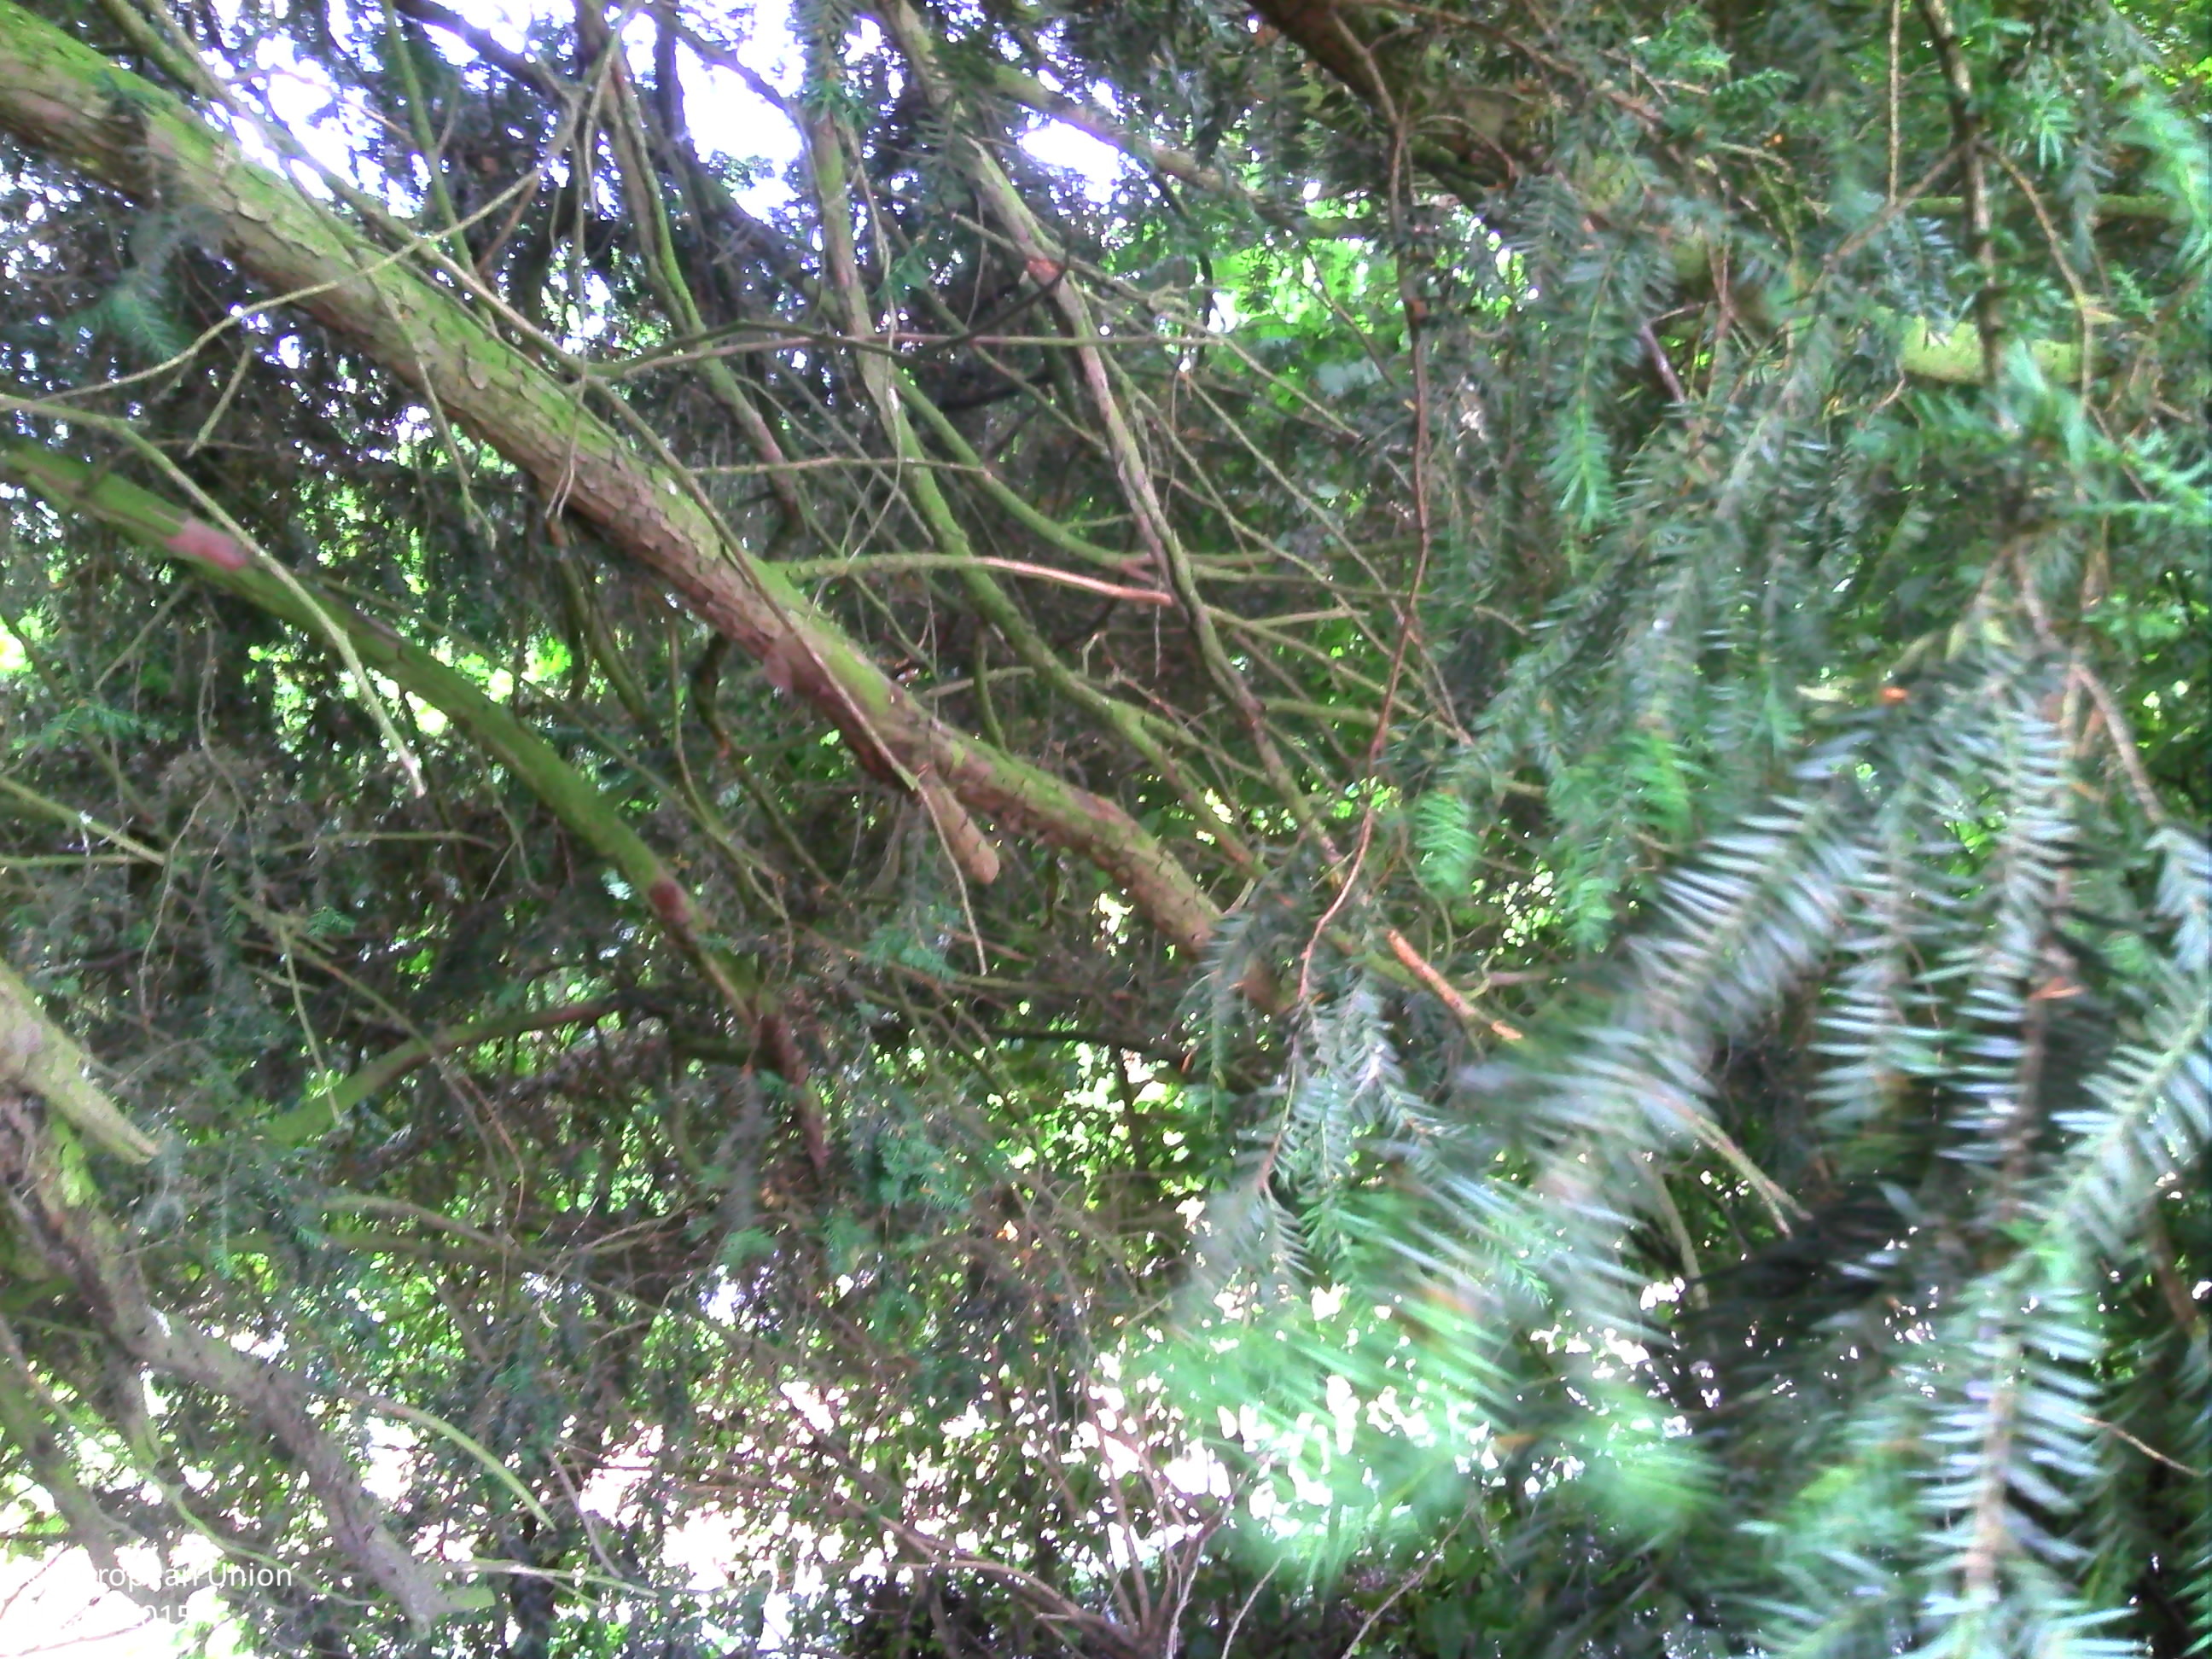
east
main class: Woodland
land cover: Spruce dominated mixed woodland
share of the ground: > 75 %
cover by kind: coniferous forest trees 75 %, broadleaved forest trees 25 %
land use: Residential
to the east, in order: Spruce dominated mixed woodland; Managed hedges; Grass margins; Paved roads, cycling and walking lanes; Lines of trees; Artificial constructions in urban areas; Spontaneously vegetated surfaces; Cherry fruit; Tracks; Cherry fruit; Tracks; Apple fruit
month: July
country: BE
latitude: 50.7708
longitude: 5.2759
